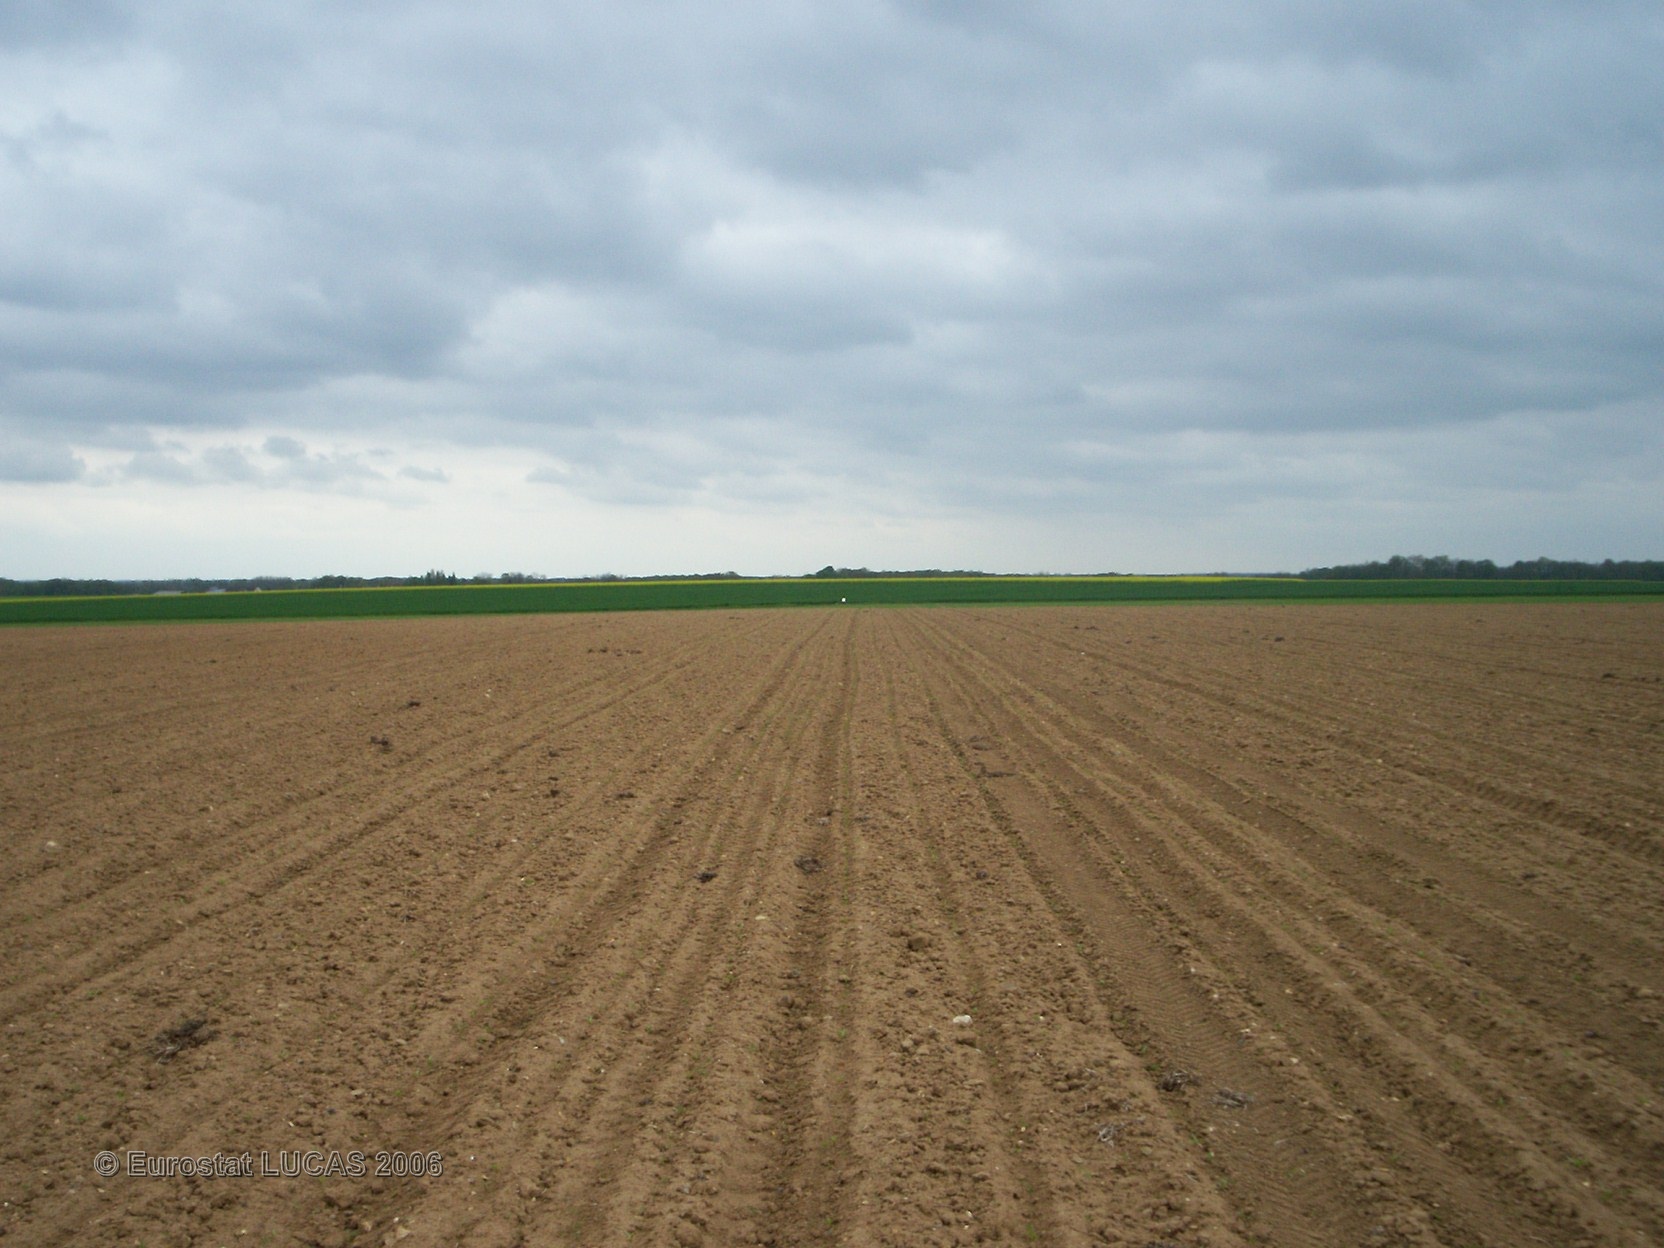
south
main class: Cropland
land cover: Sugar beet
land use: Agriculture (excluding fallow land and kitchen gardens)
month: May
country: FR
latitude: 48.1558
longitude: 2.8807
